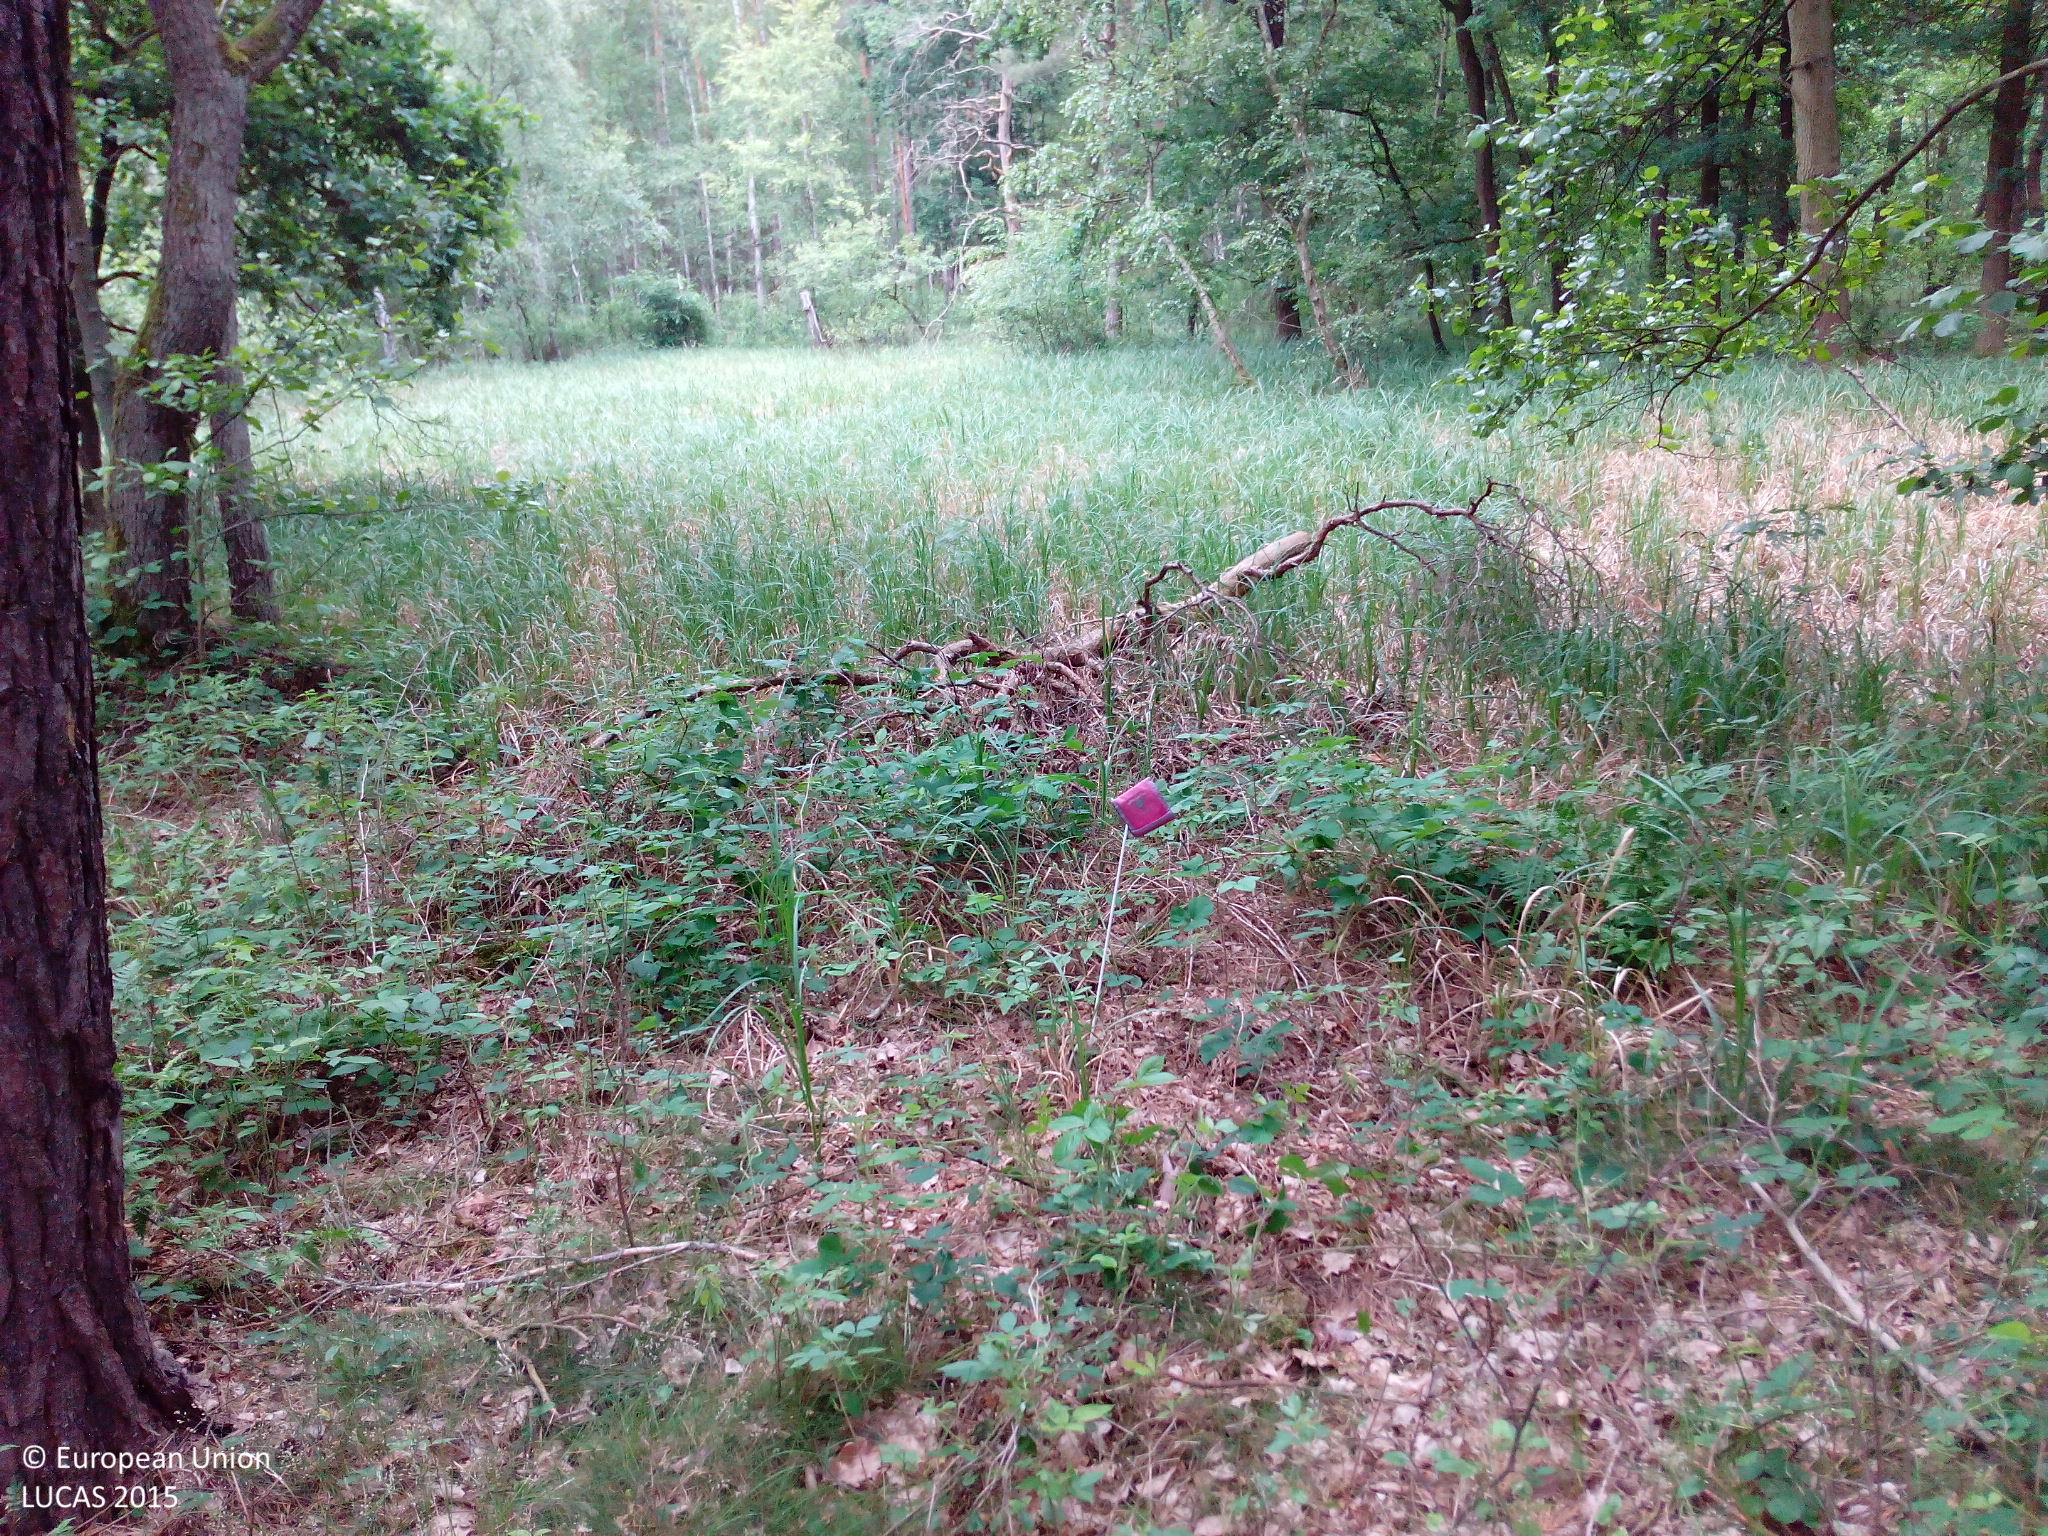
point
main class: Woodland
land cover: Broadleaved woodland
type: mesophytic deciduous forest
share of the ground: > 75 %
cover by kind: broadleaved forest trees 60 %, coniferous forest trees 20 %, shrubs 15 %, lichens and mosses 5 %
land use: Forestry
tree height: > 5 m
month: June
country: DE
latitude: 52.5498
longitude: 12.4624
